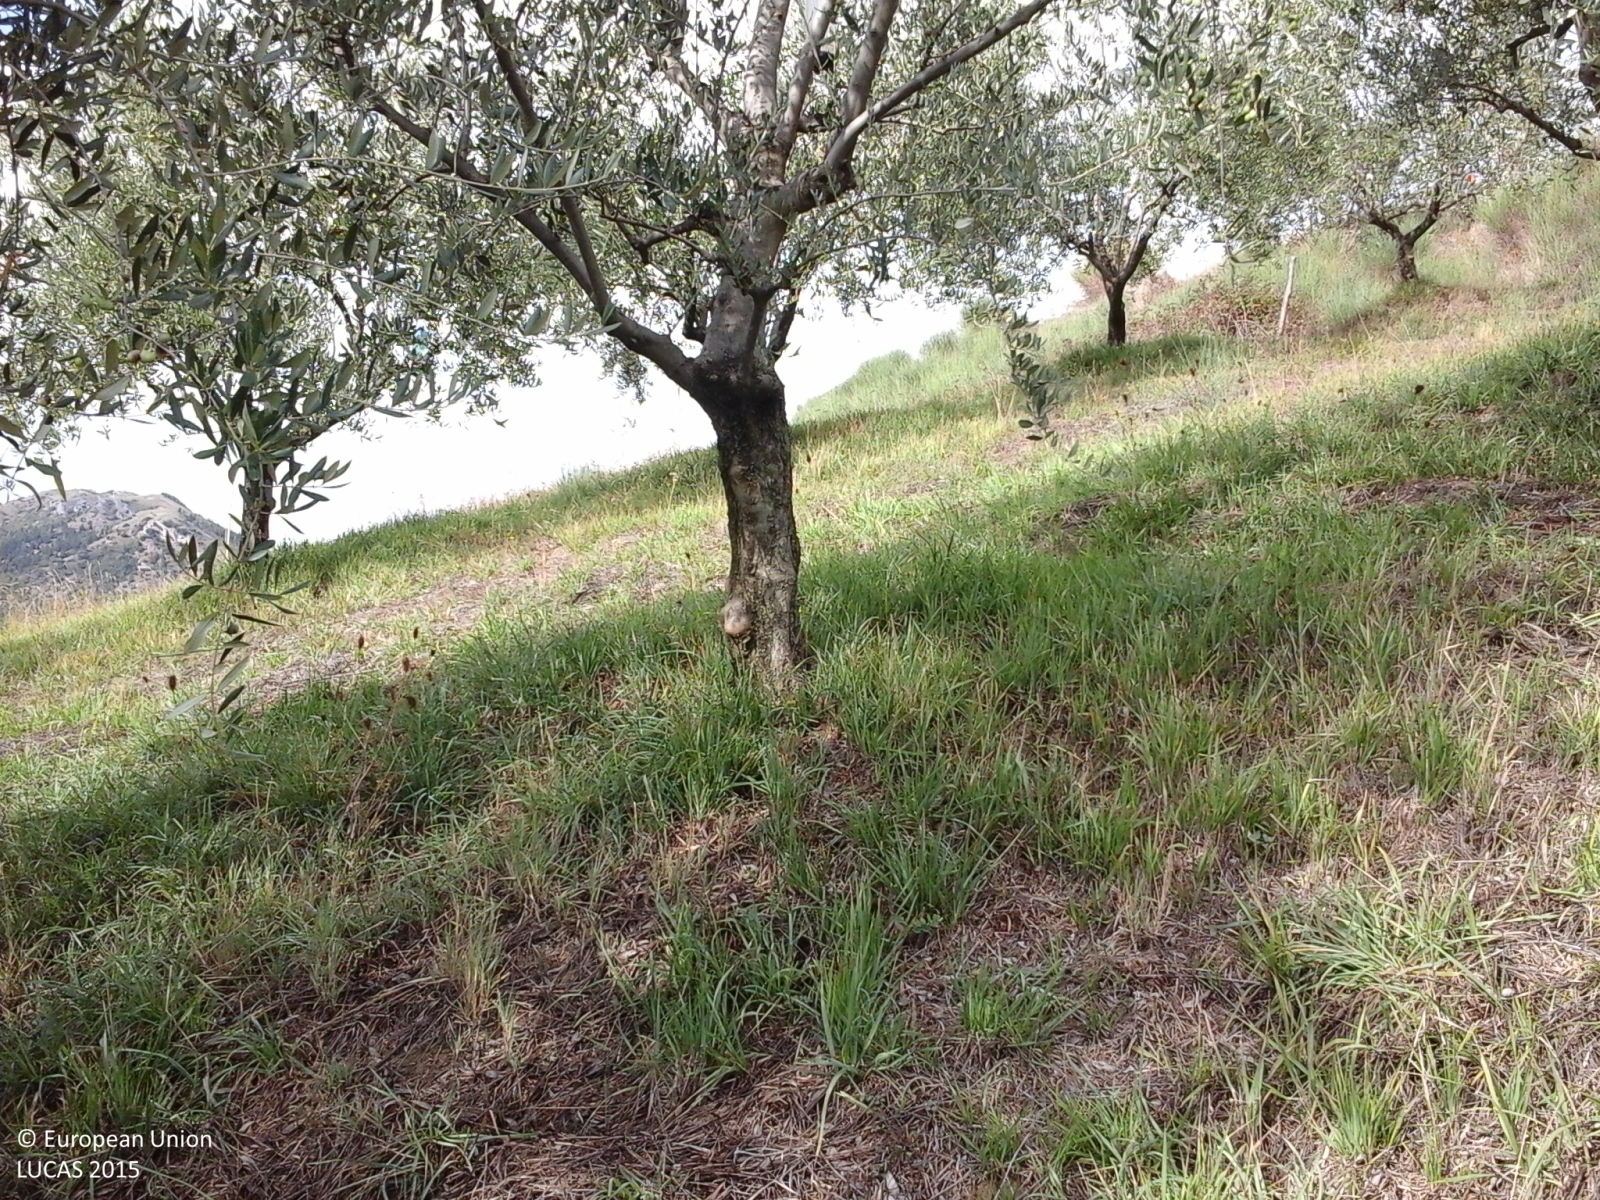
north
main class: Cropland
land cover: Olive groves
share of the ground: 50 - 75 %
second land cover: Spontaneously vegetated surfaces
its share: > 75 %
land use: Agriculture (excluding fallow land and kitchen gardens)
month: October
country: IT
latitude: 43.3247
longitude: 12.6196
